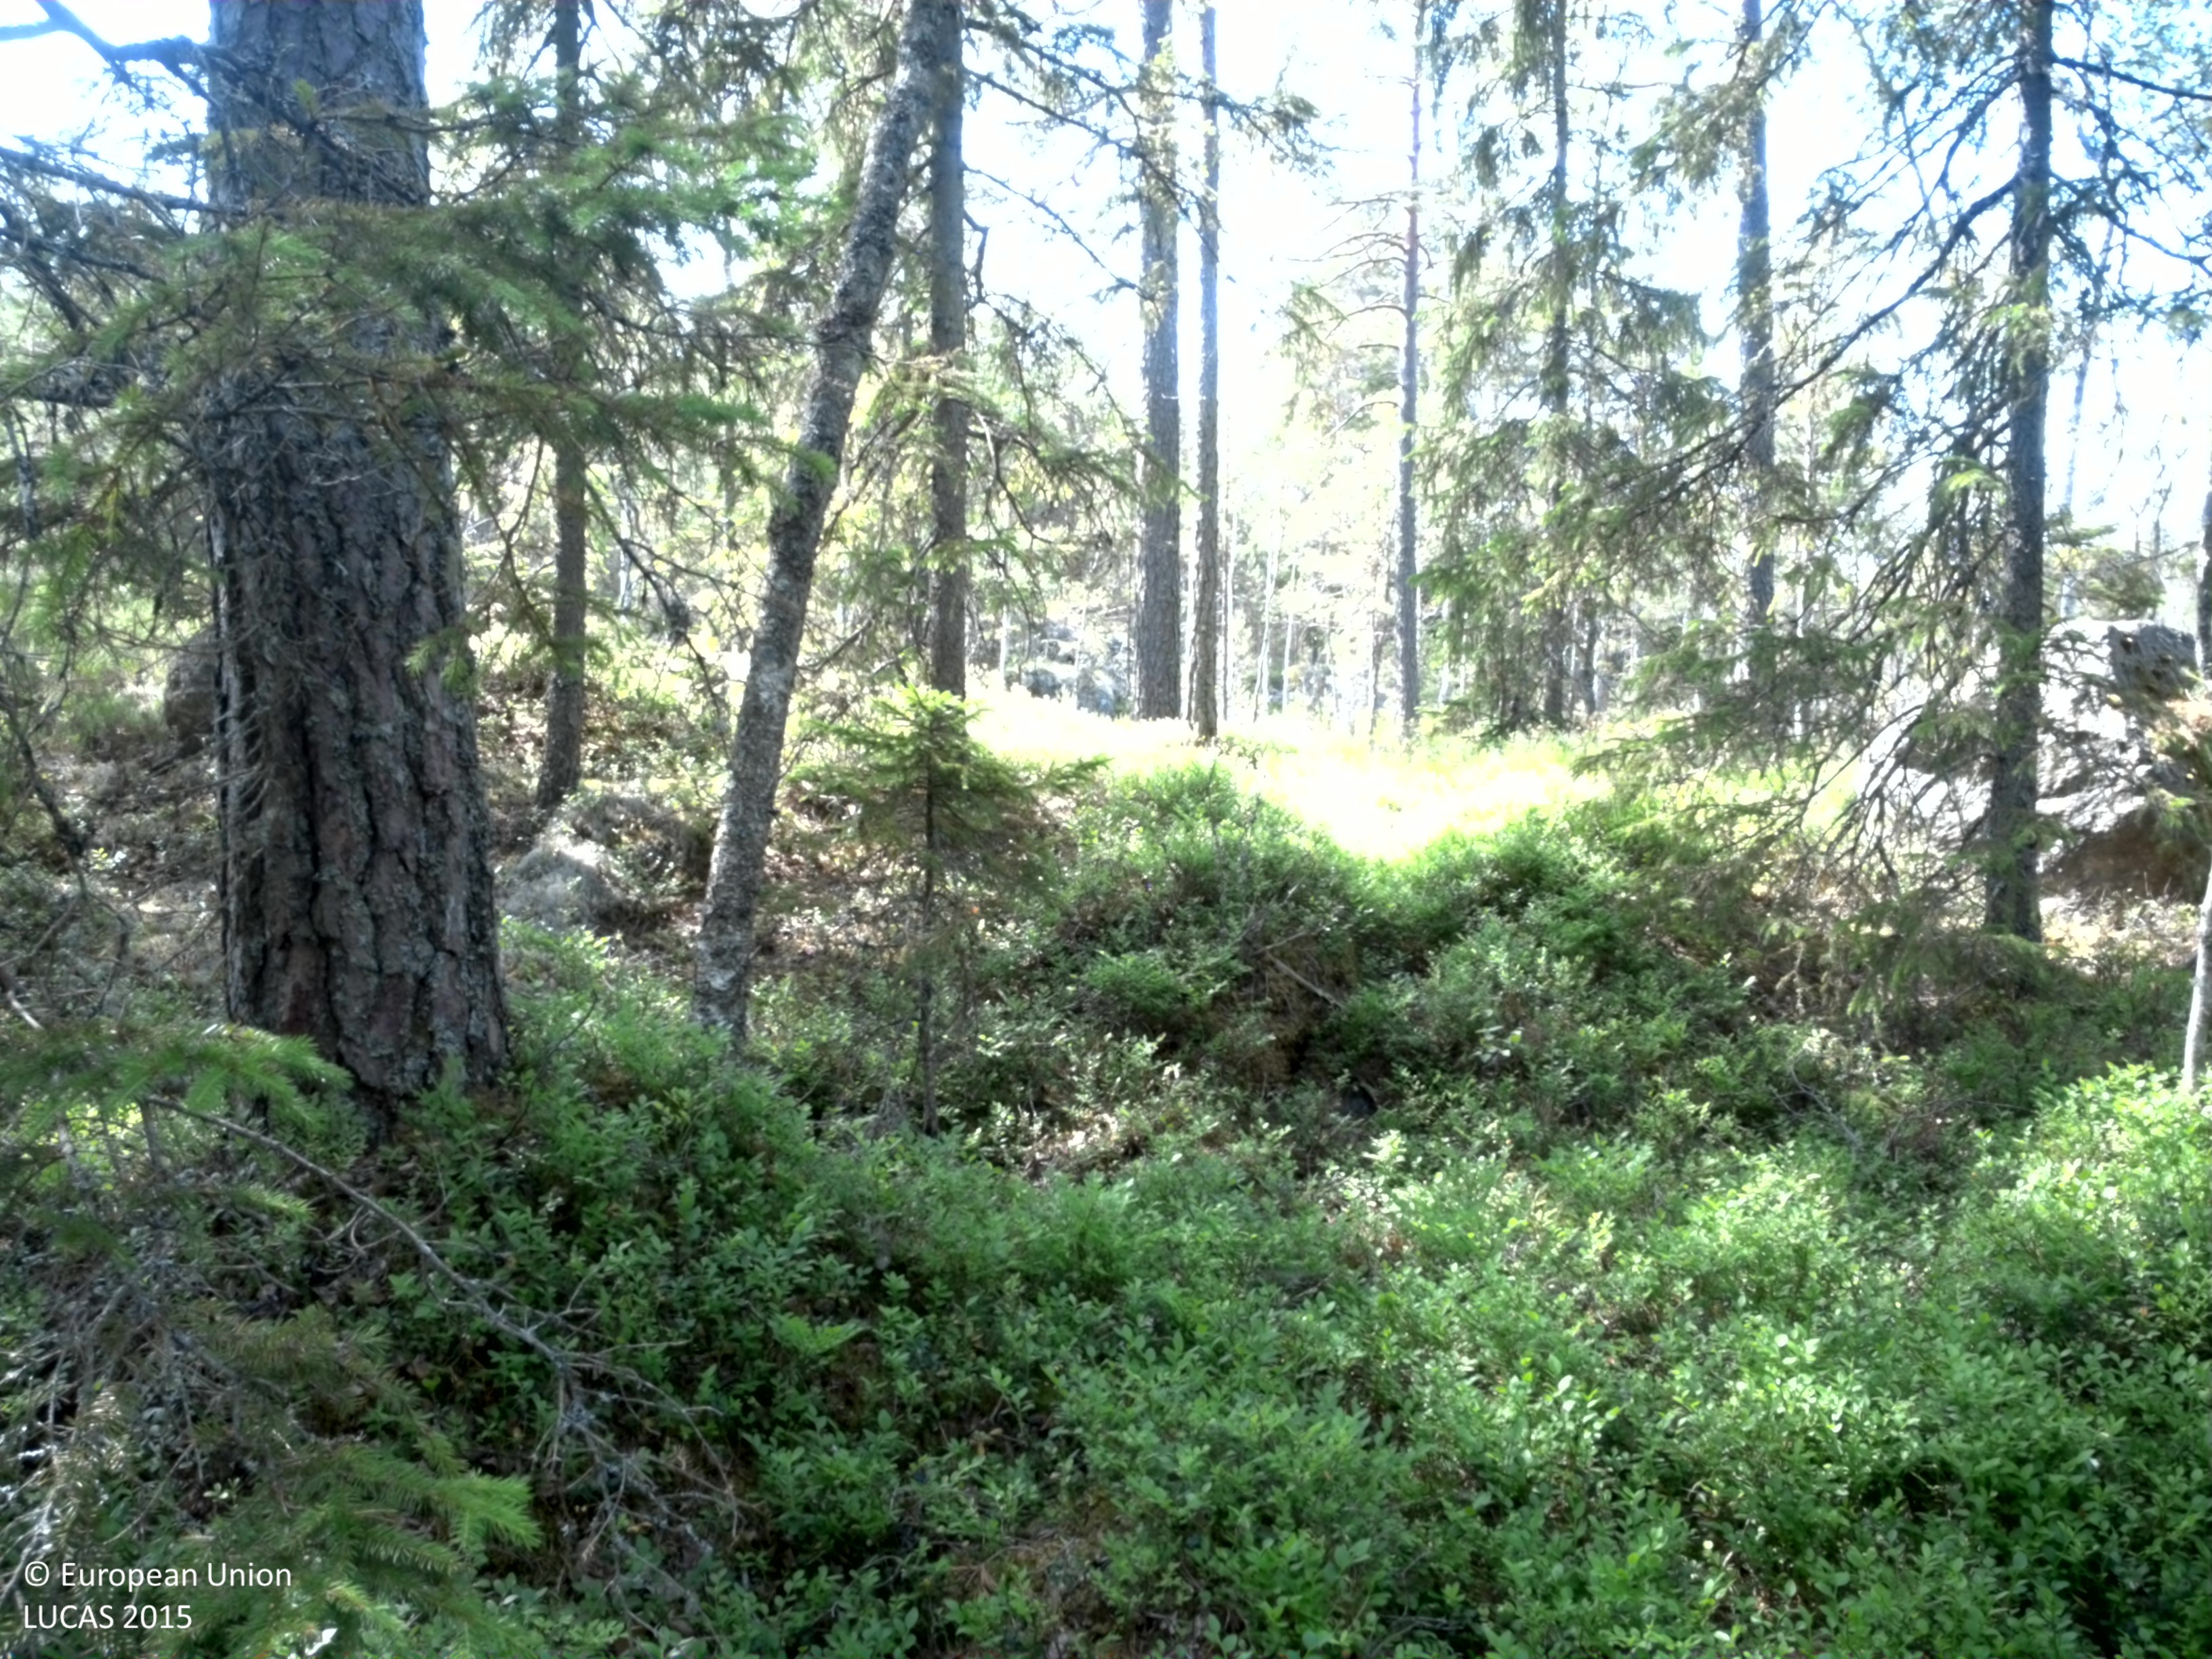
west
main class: Woodland
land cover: Pine dominated mixed woodland
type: boreal forest
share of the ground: 50 - 75 %
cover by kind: coniferous forest trees 50 %, broadleaved forest trees 20 %, shrubs 15 %, herbaceous plants 10 %, consolidated bare surface 5 %
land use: Forestry
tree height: > 5 m
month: July
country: SE
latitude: 59.2772
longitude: 14.5718
